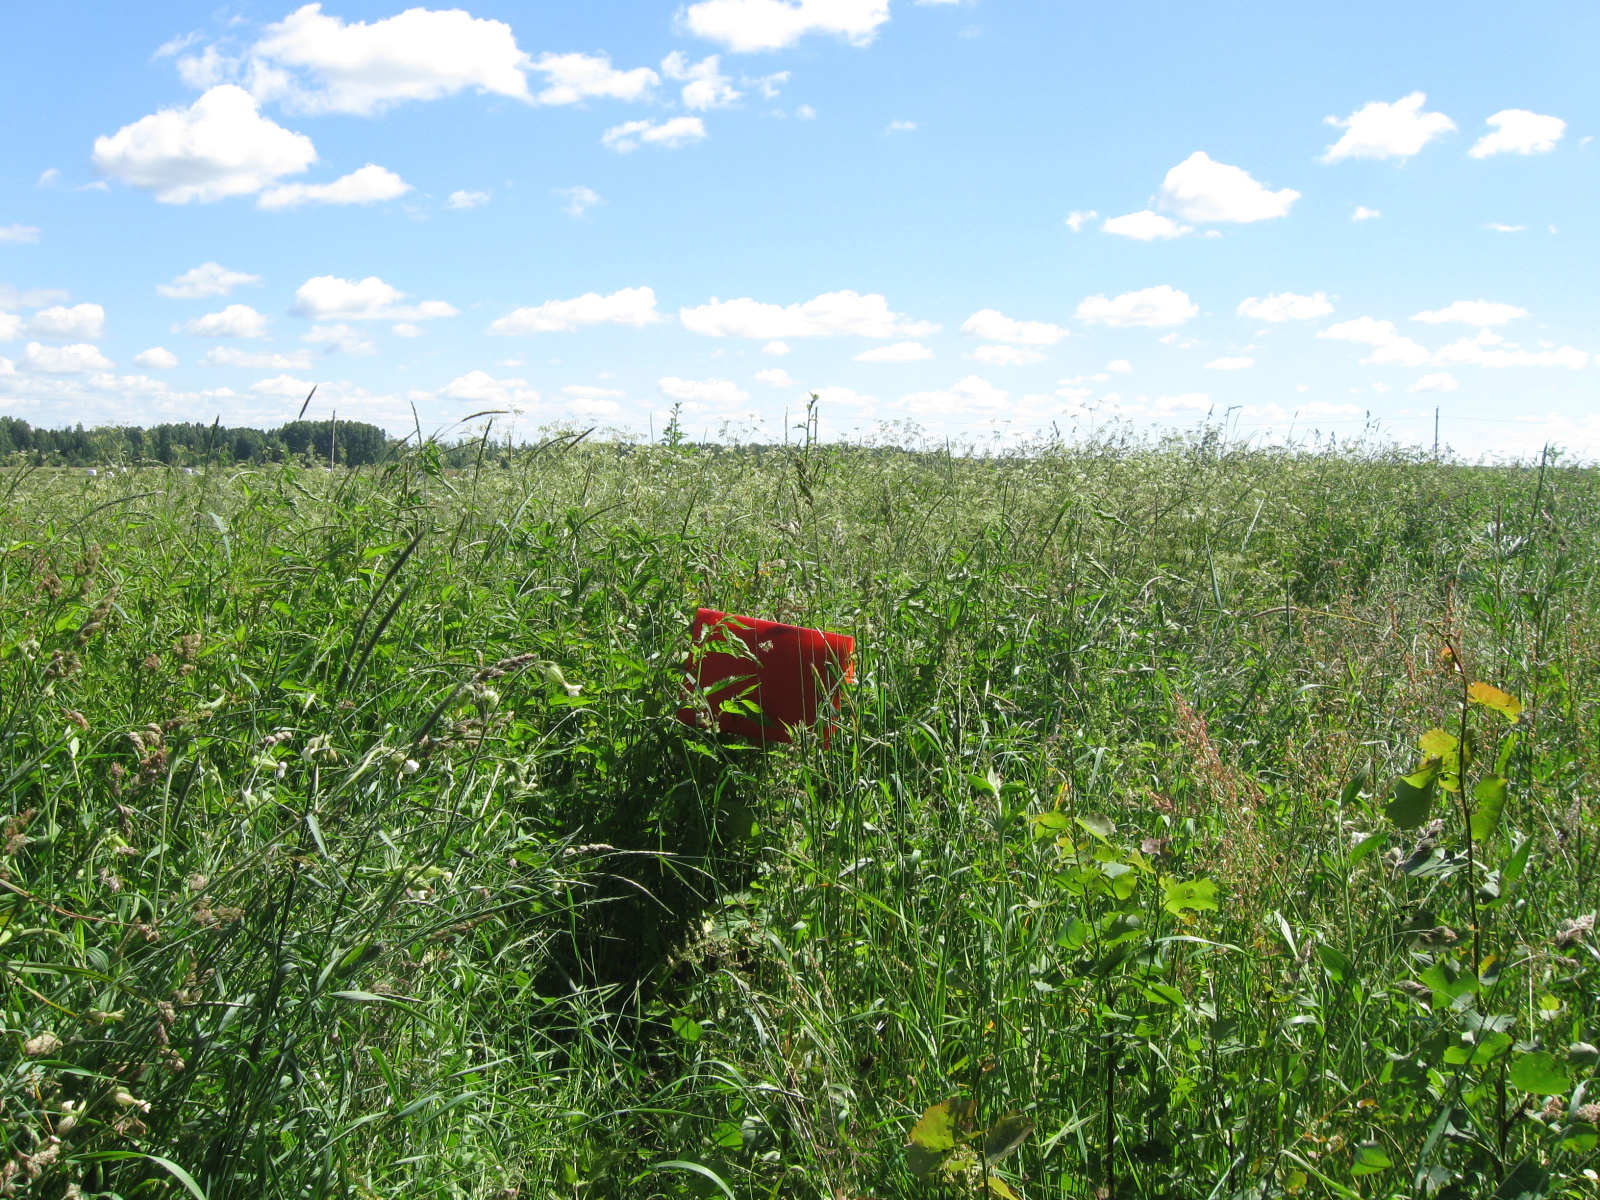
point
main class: Grassland
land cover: Spontaneously vegetated surfaces
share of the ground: > 75 %
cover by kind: herbaceous plants 100 %
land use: Abandoned areas
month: June
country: LT
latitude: 53.9798
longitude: 24.7013
